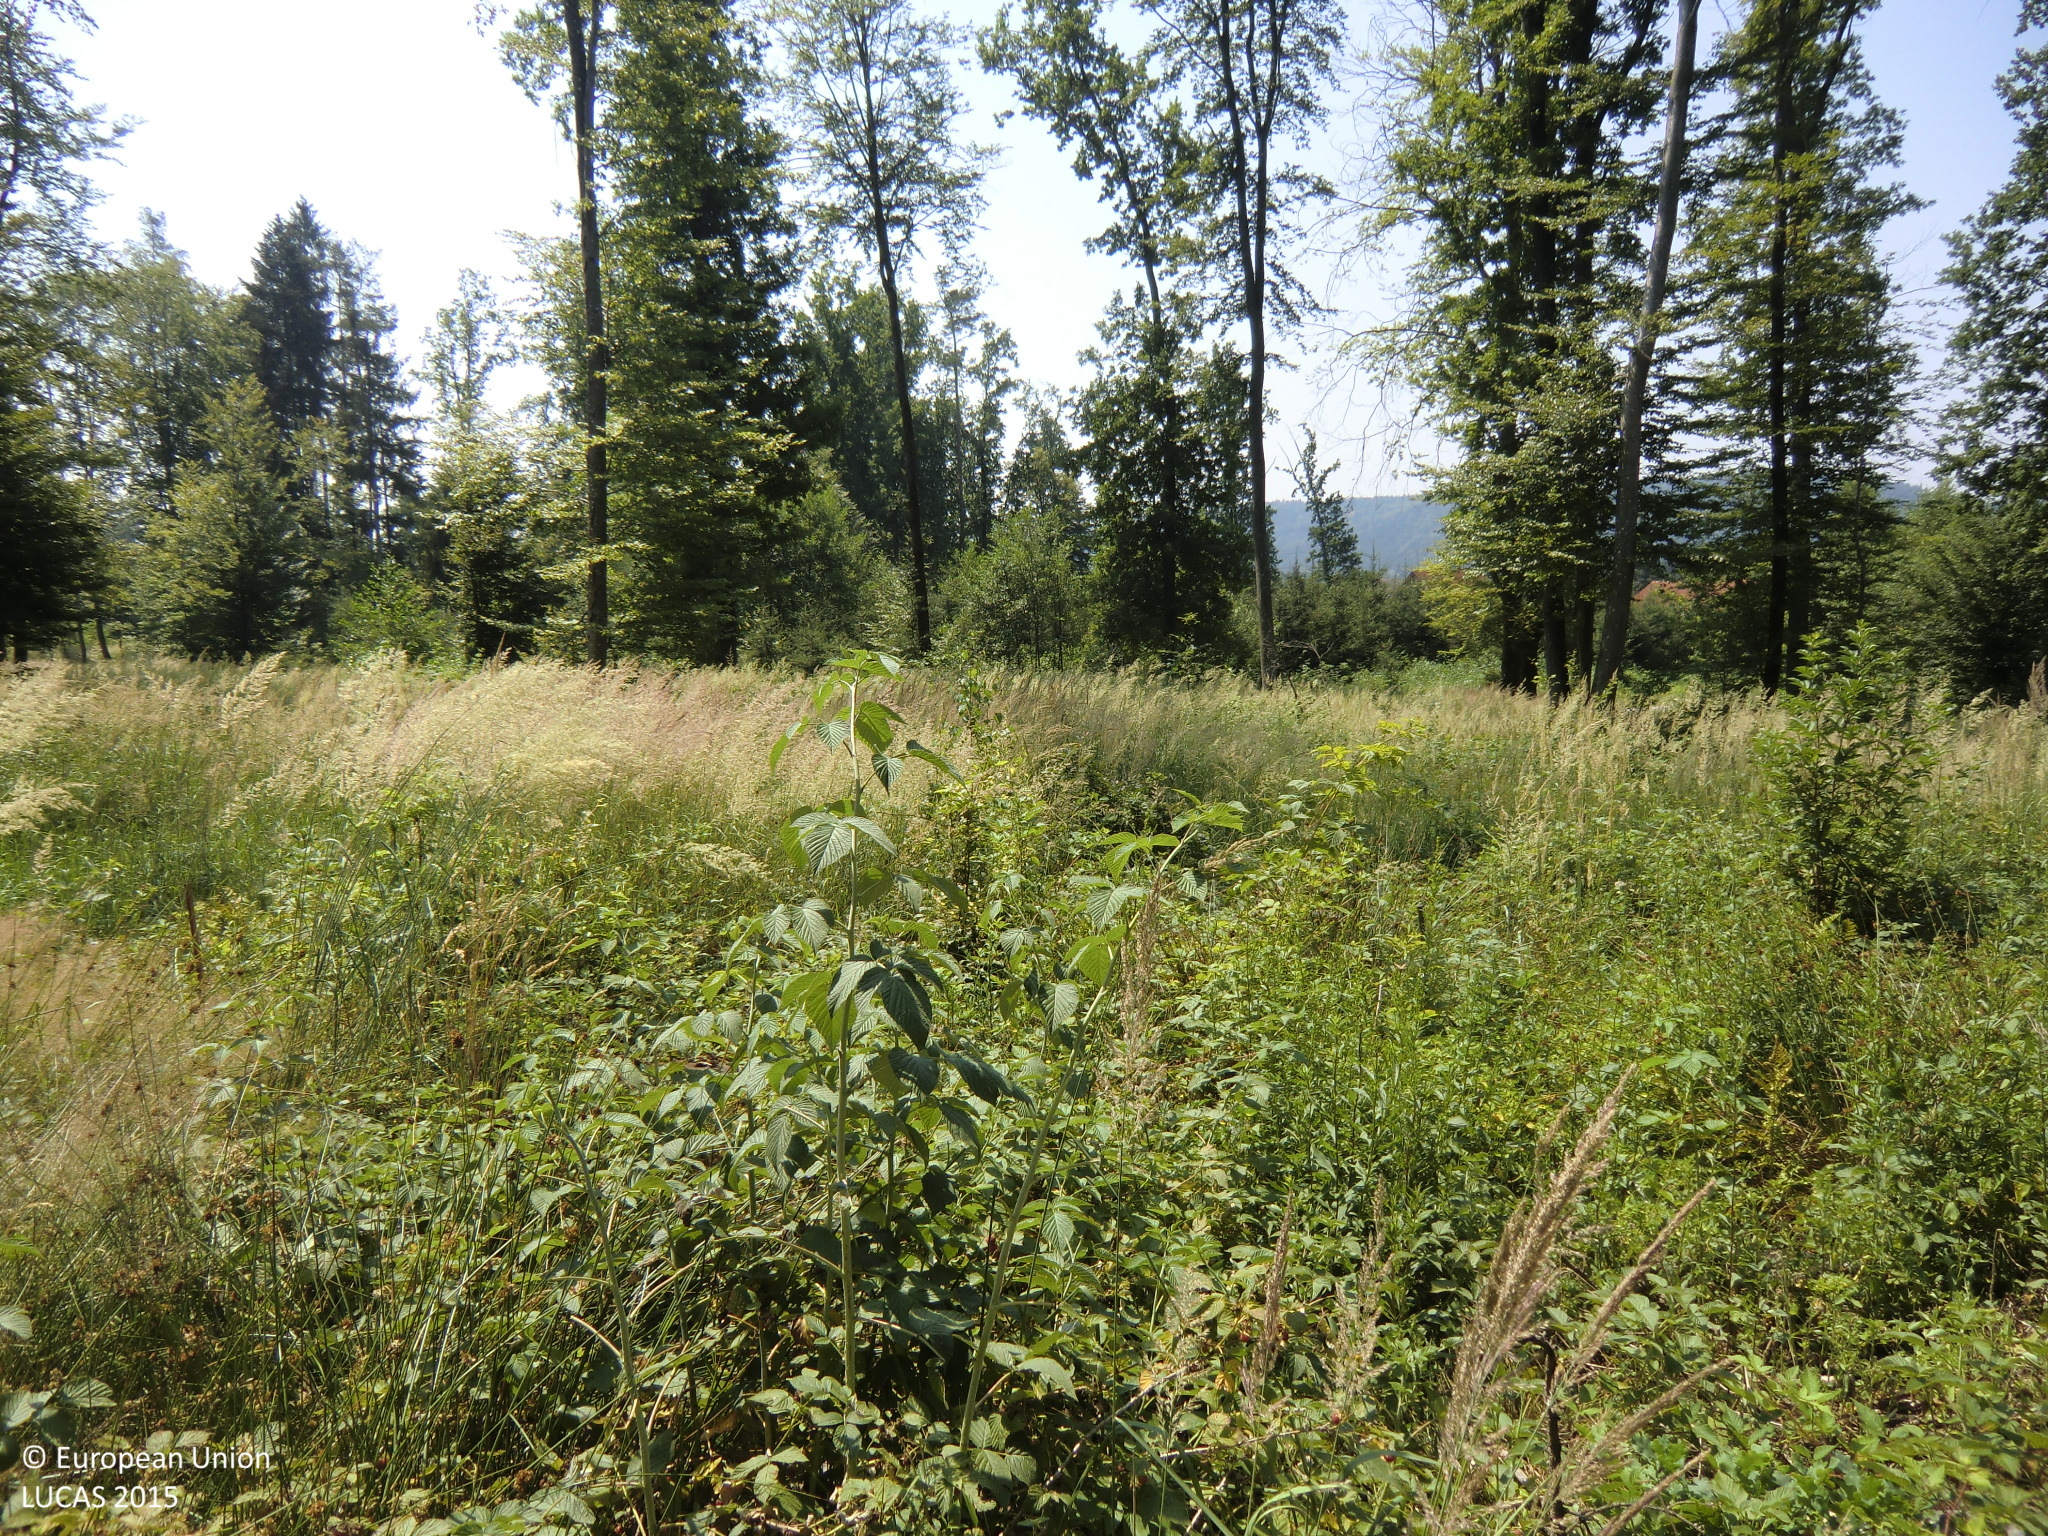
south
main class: Shrubland
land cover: Shrubland with sparse tree cover
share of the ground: > 75 %
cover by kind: herbaceous plants 55 %, shrubs 40 %, broadleaved forest trees 5 %
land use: Forestry
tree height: < 5 m
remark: Clear cut
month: July
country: AT
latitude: 47.1001
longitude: 15.7320
